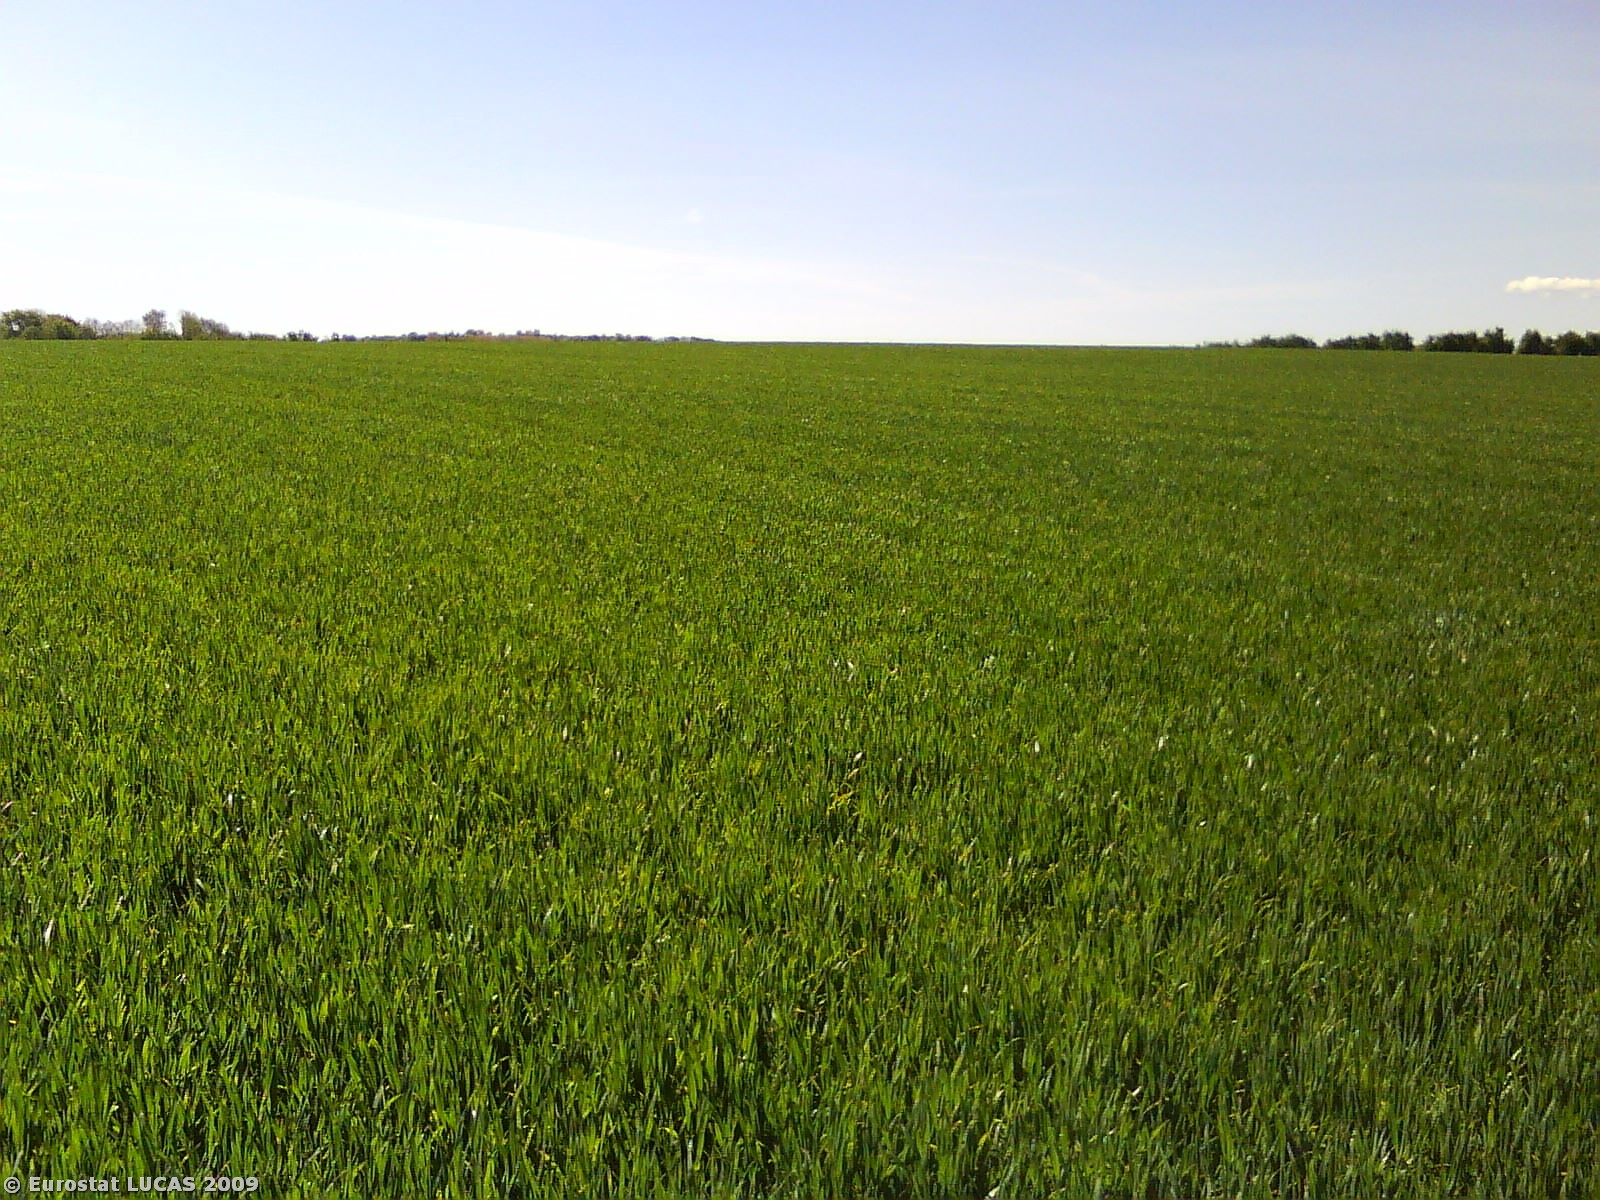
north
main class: Cropland
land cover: Common wheat
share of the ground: > 75 %
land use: Agriculture (excluding fallow land and kitchen gardens)
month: May
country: DK
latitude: 56.3824
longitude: 10.8896
